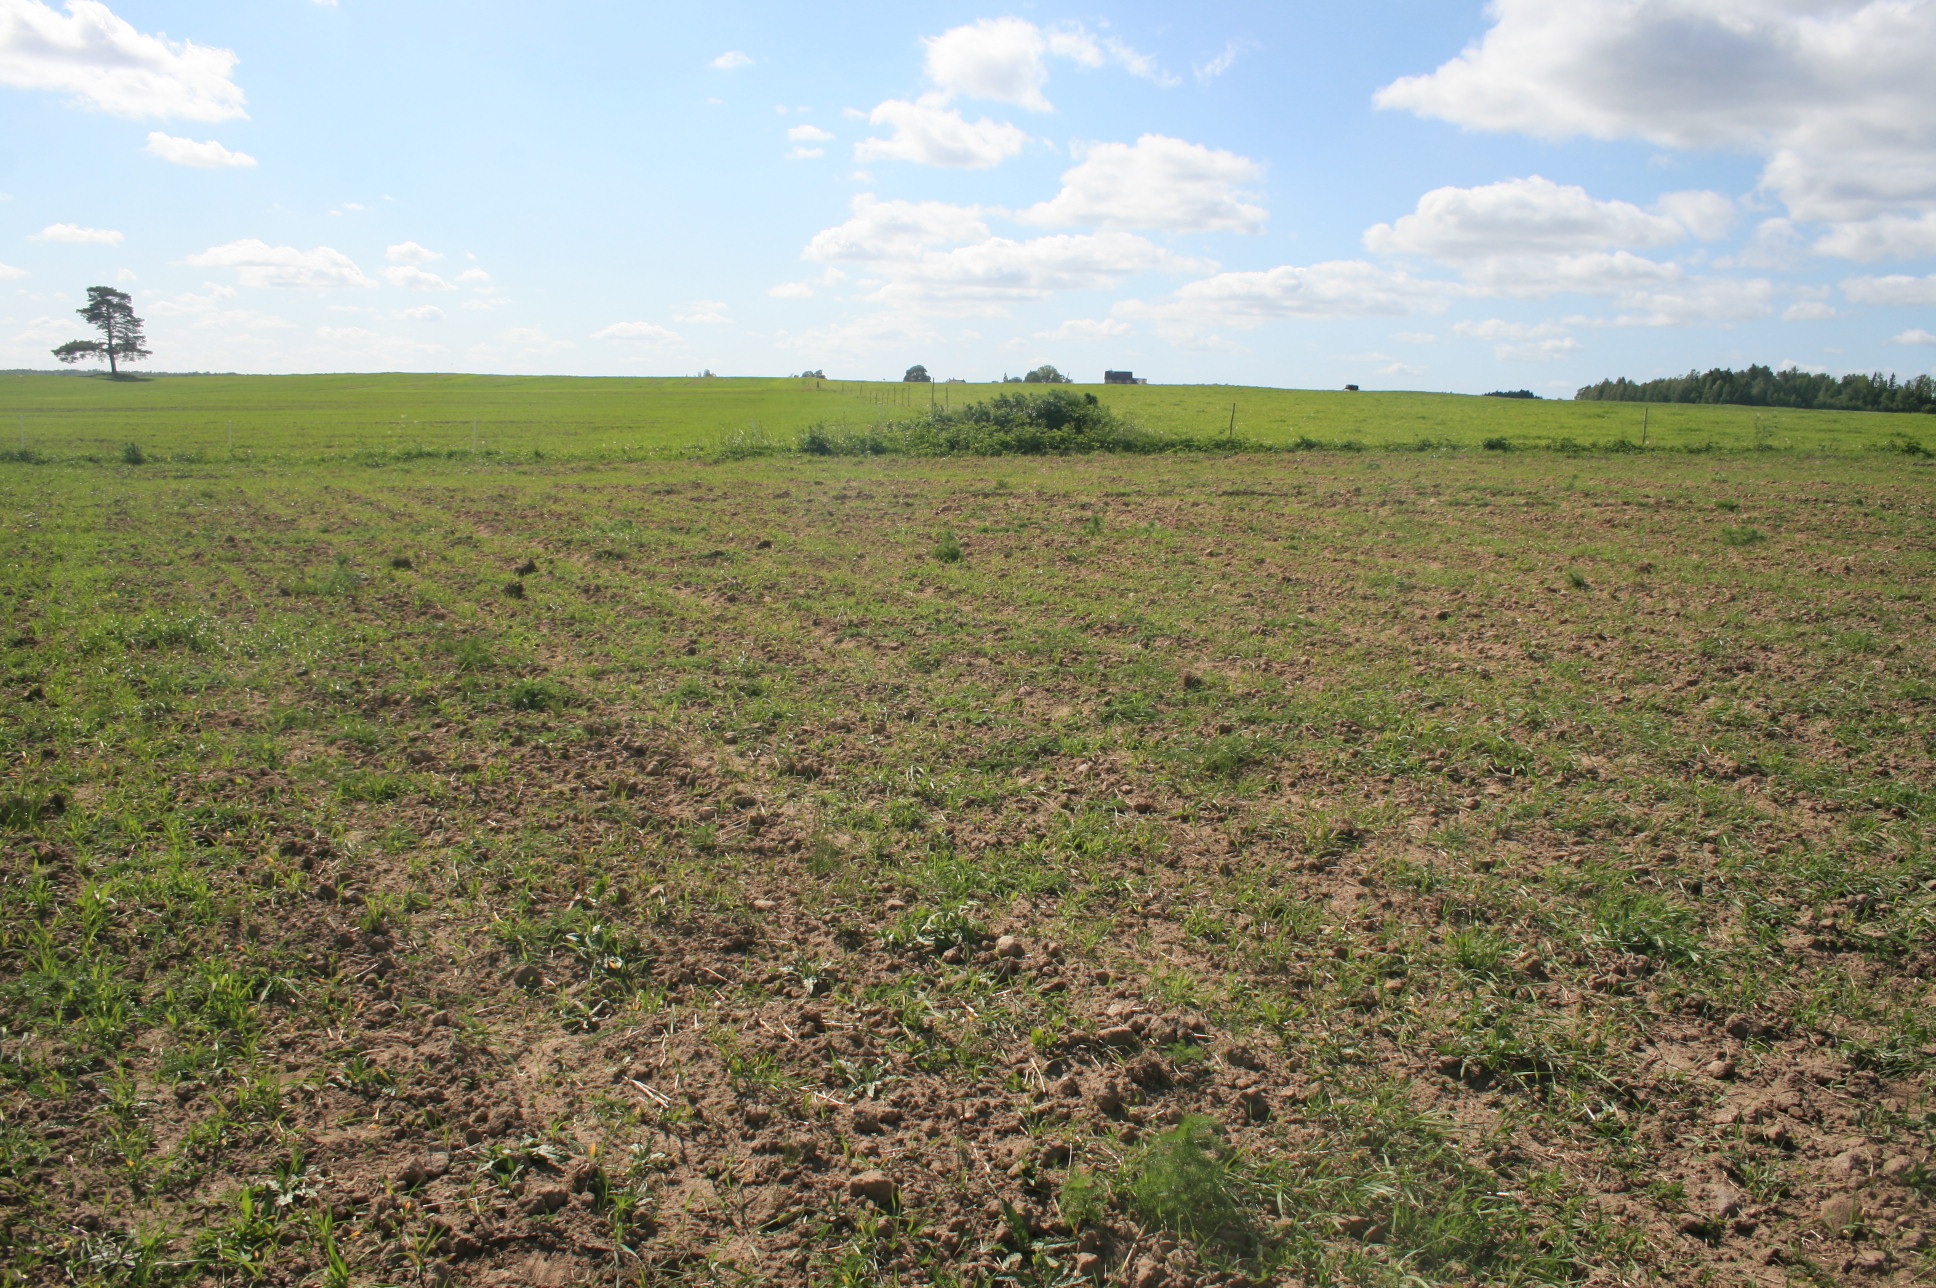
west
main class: Cropland
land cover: Barley
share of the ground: > 75 %
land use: Agriculture (excluding fallow land and kitchen gardens)
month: June
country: LT
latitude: 56.0449
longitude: 22.3373
